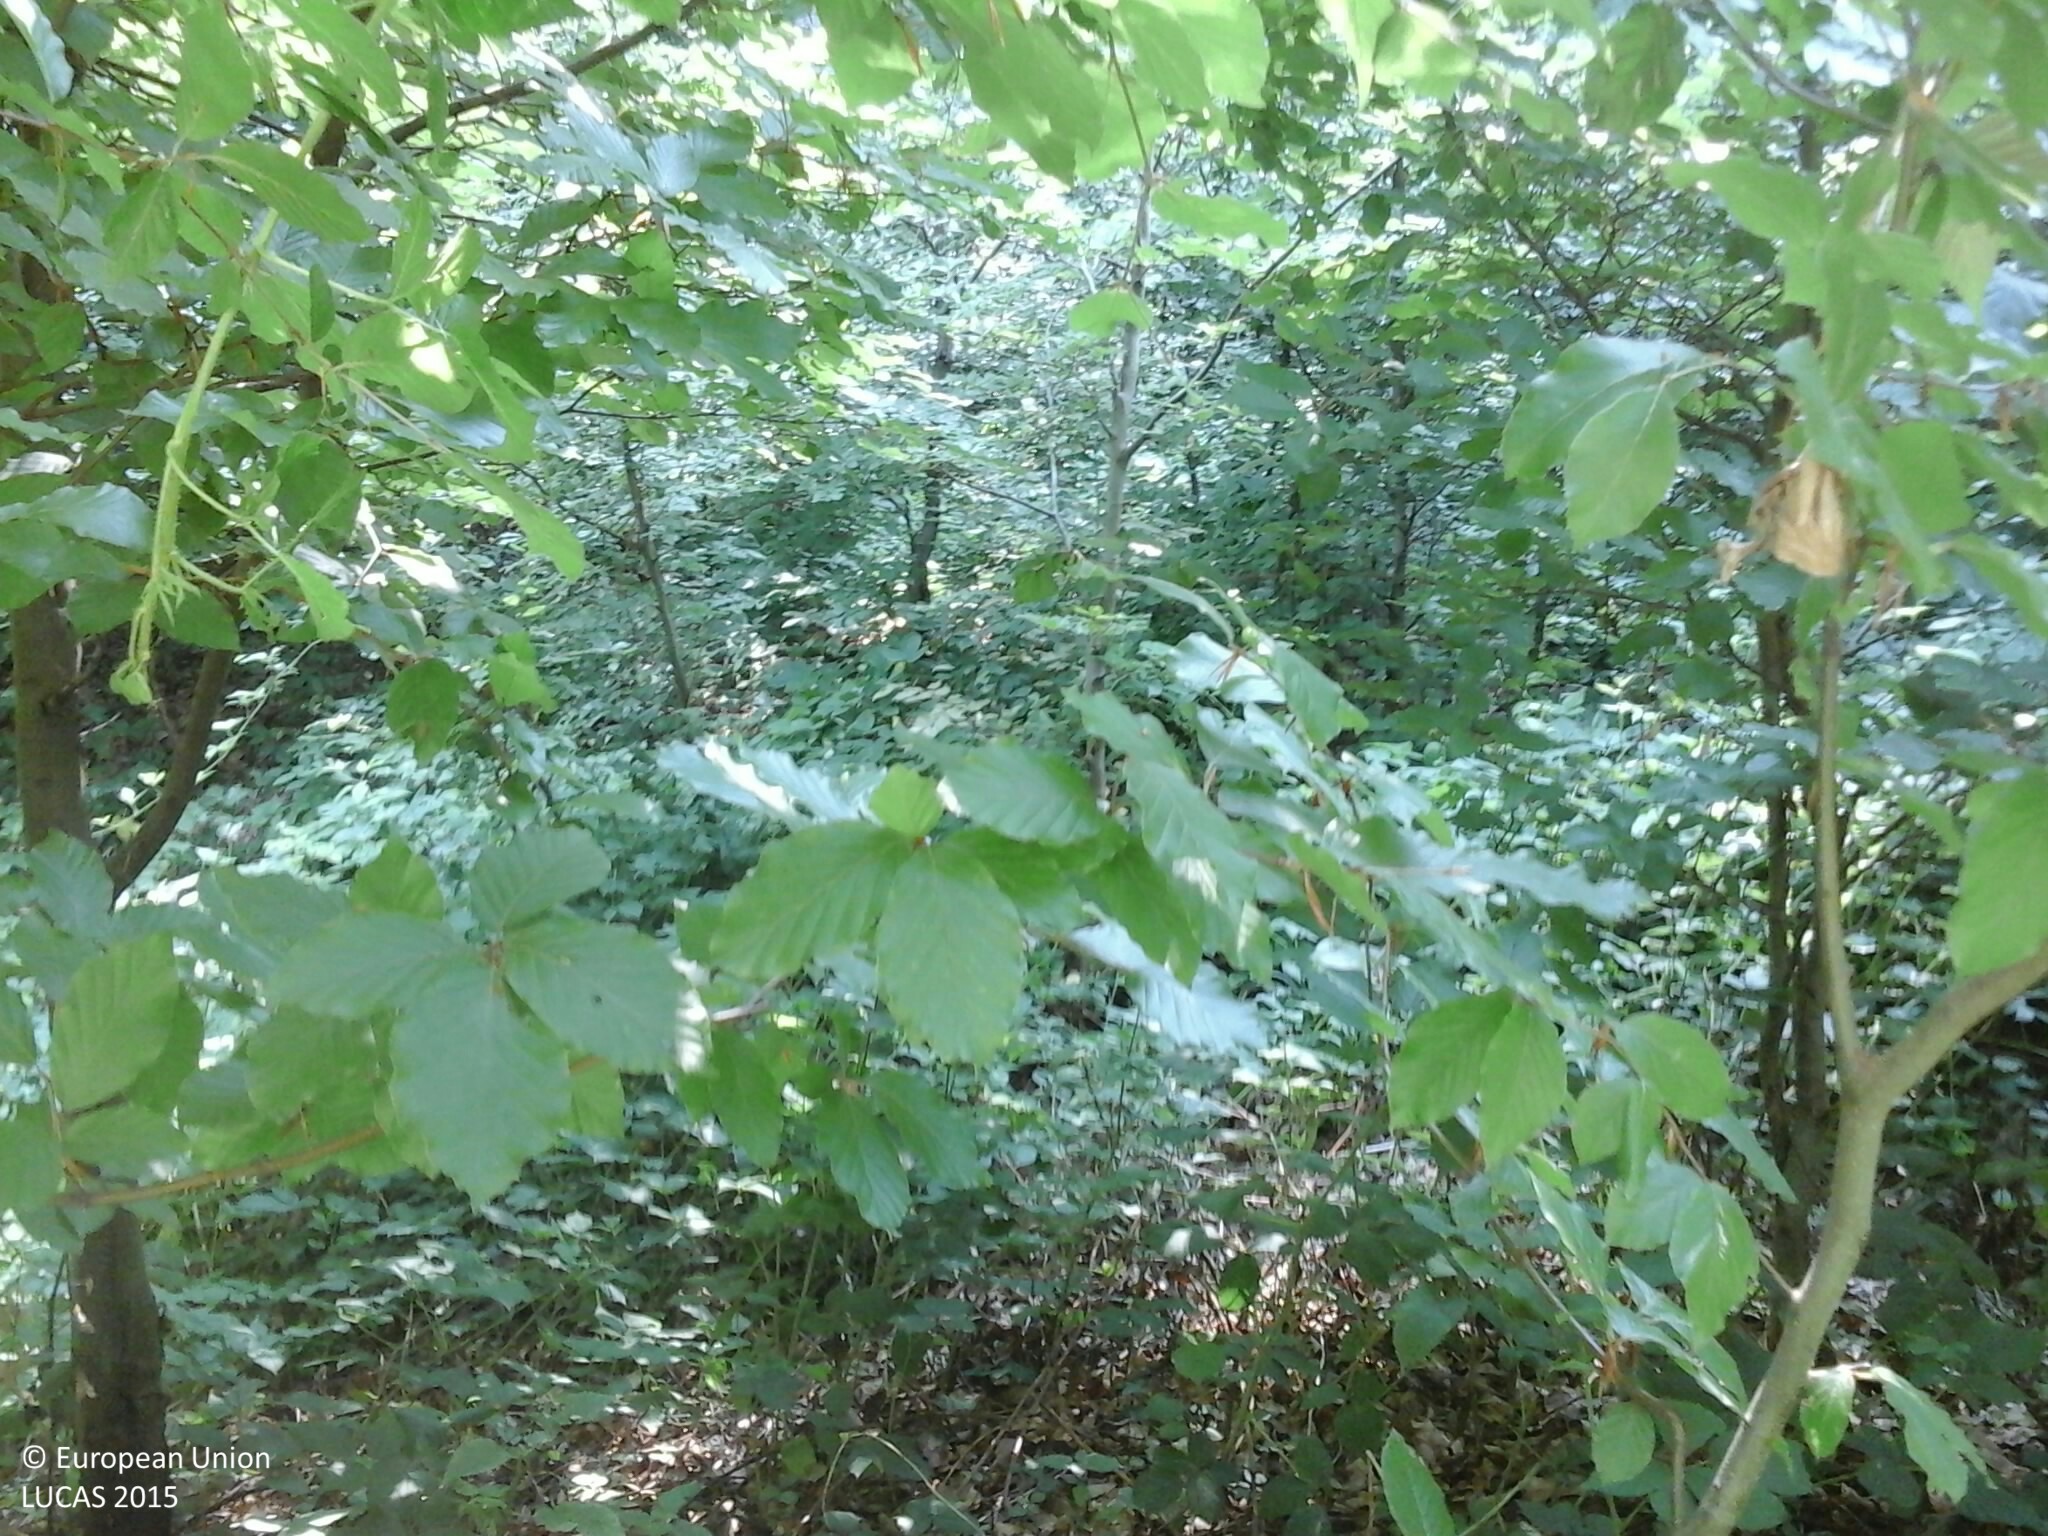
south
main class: Woodland
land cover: Broadleaved woodland
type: beech forest
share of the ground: > 75 %
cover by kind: broadleaved forest trees 100 %
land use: Forestry
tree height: > 5 m
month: August
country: HU
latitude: 46.1285
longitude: 18.1737
